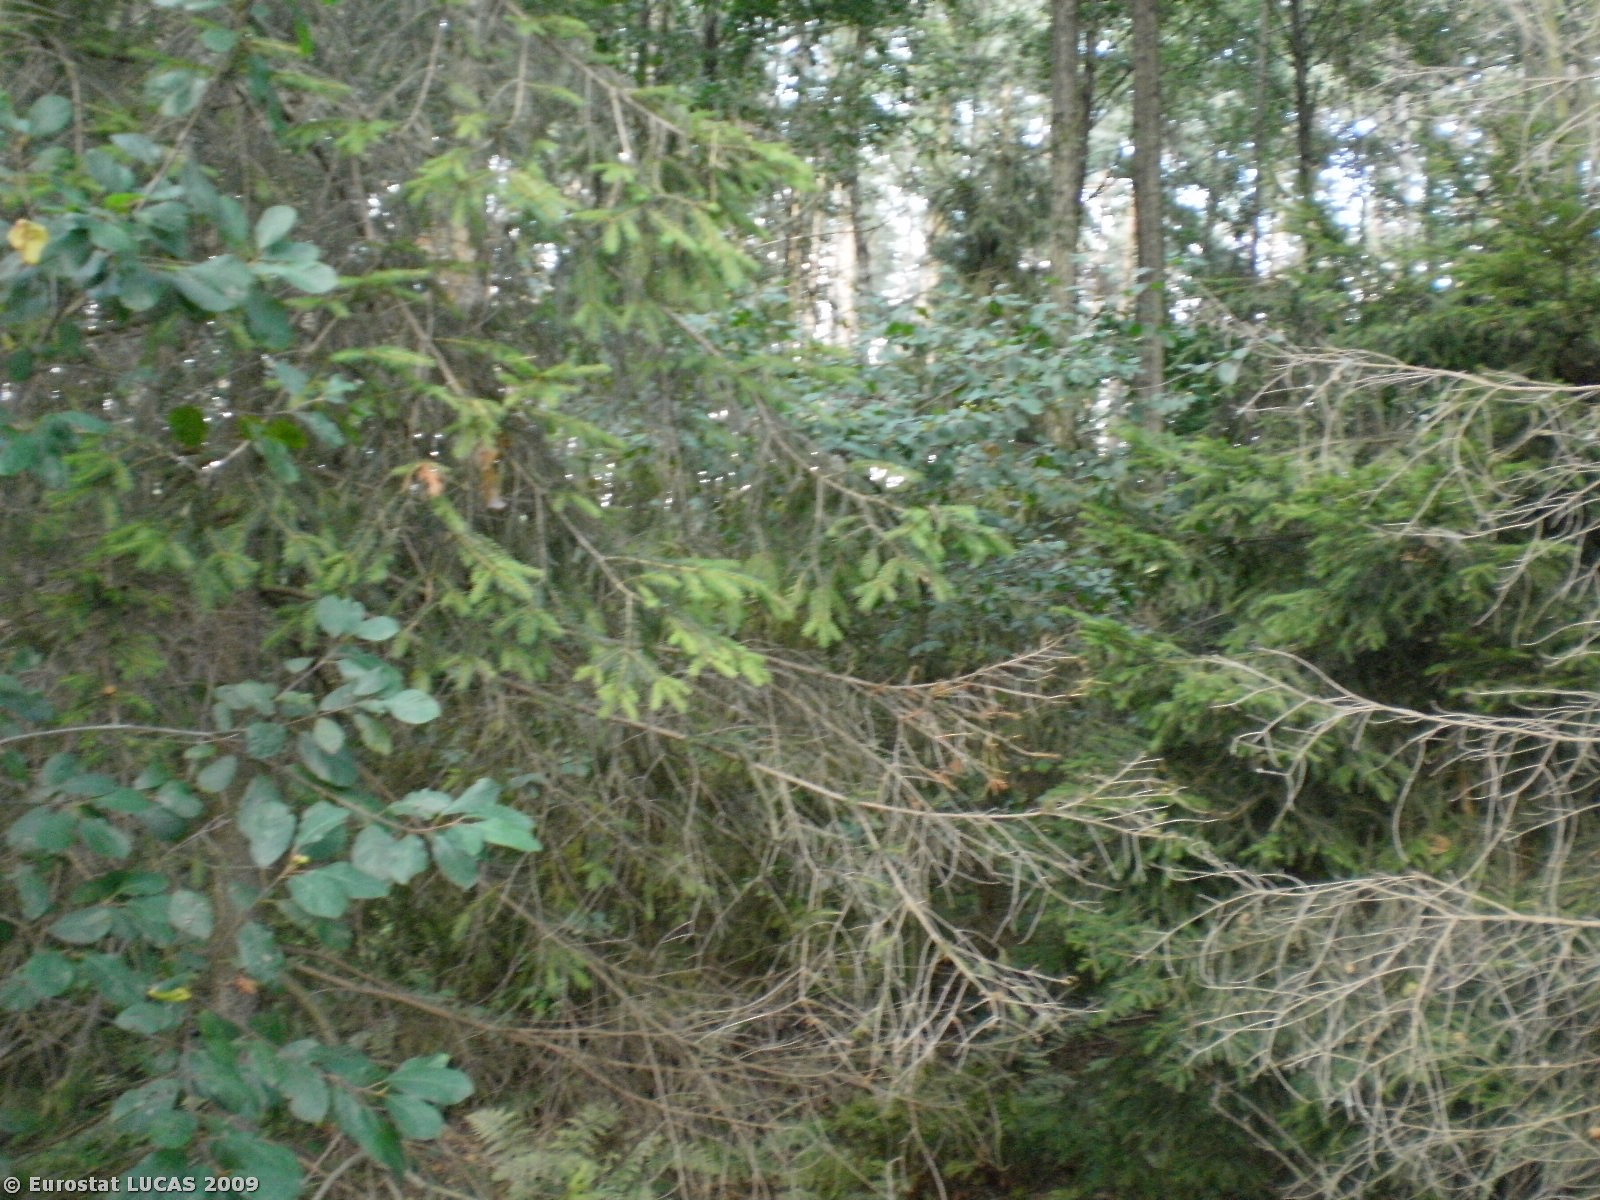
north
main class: Woodland
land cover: Mixed woodland
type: hemiboreal forest and nemoral coniferous forest and mixed broadleaved-coniferous forest
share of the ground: > 75 %
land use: Forestry
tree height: > 5 m
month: August
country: PL
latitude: 52.7672
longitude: 21.8082
